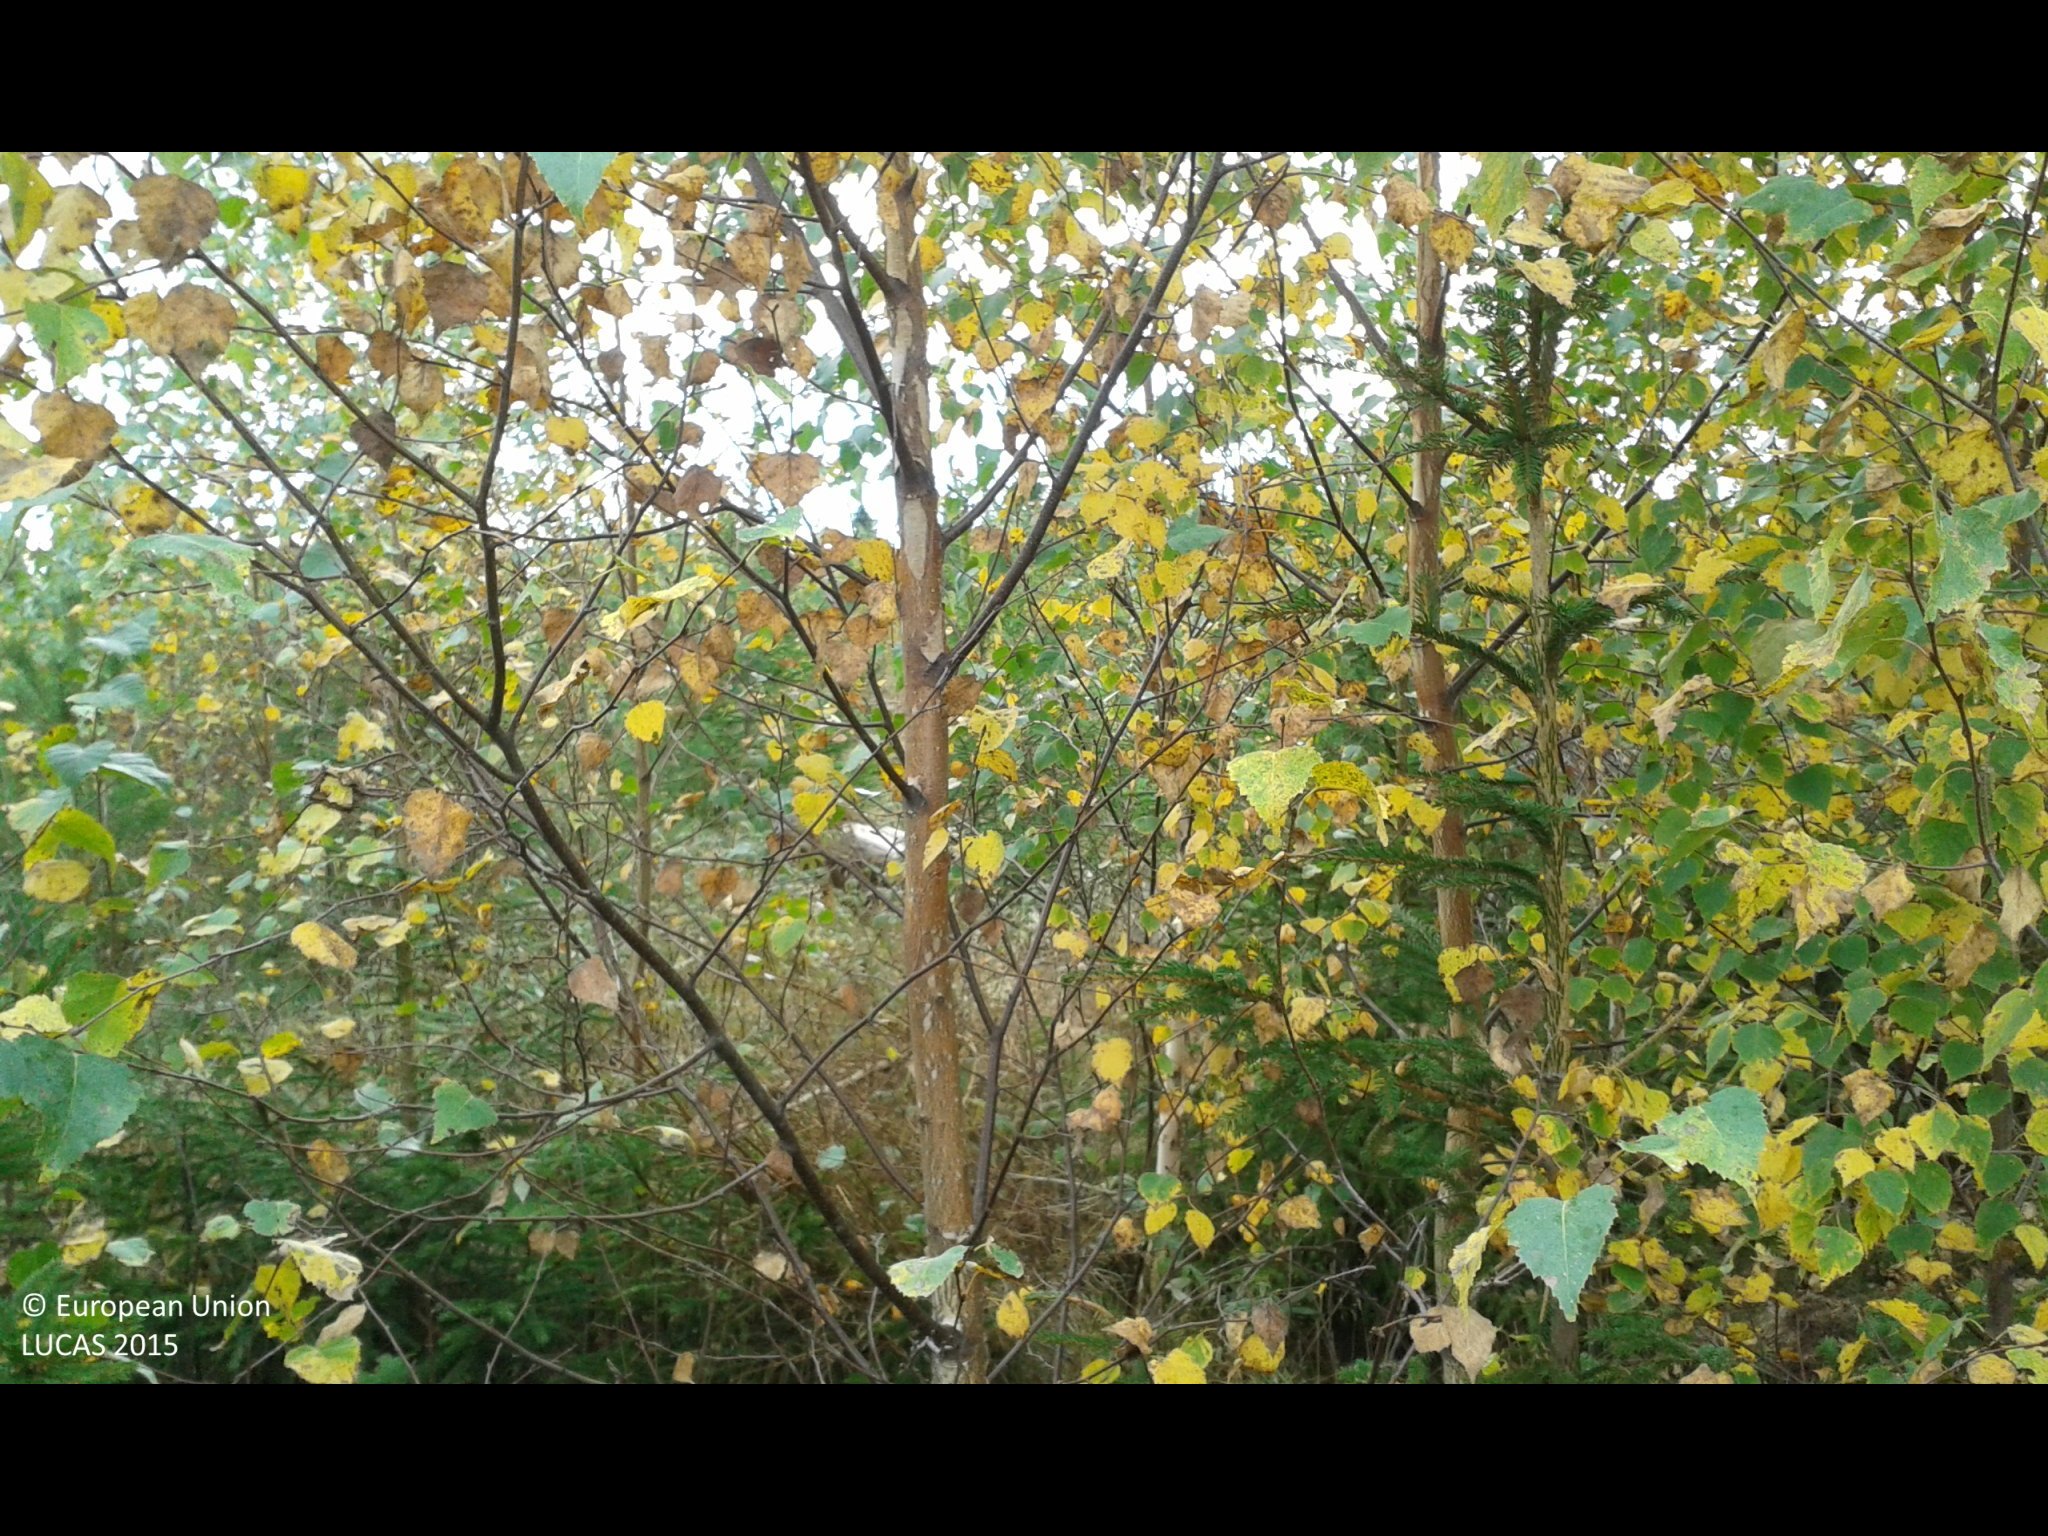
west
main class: Woodland
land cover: Spruce dominated mixed woodland
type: boreal forest
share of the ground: 50 - 75 %
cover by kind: coniferous forest trees 45 %, herbaceous plants 40 %, broadleaved forest trees 15 %
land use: Forestry
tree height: < 5 m
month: October
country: SE
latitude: 58.8832
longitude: 17.0573
